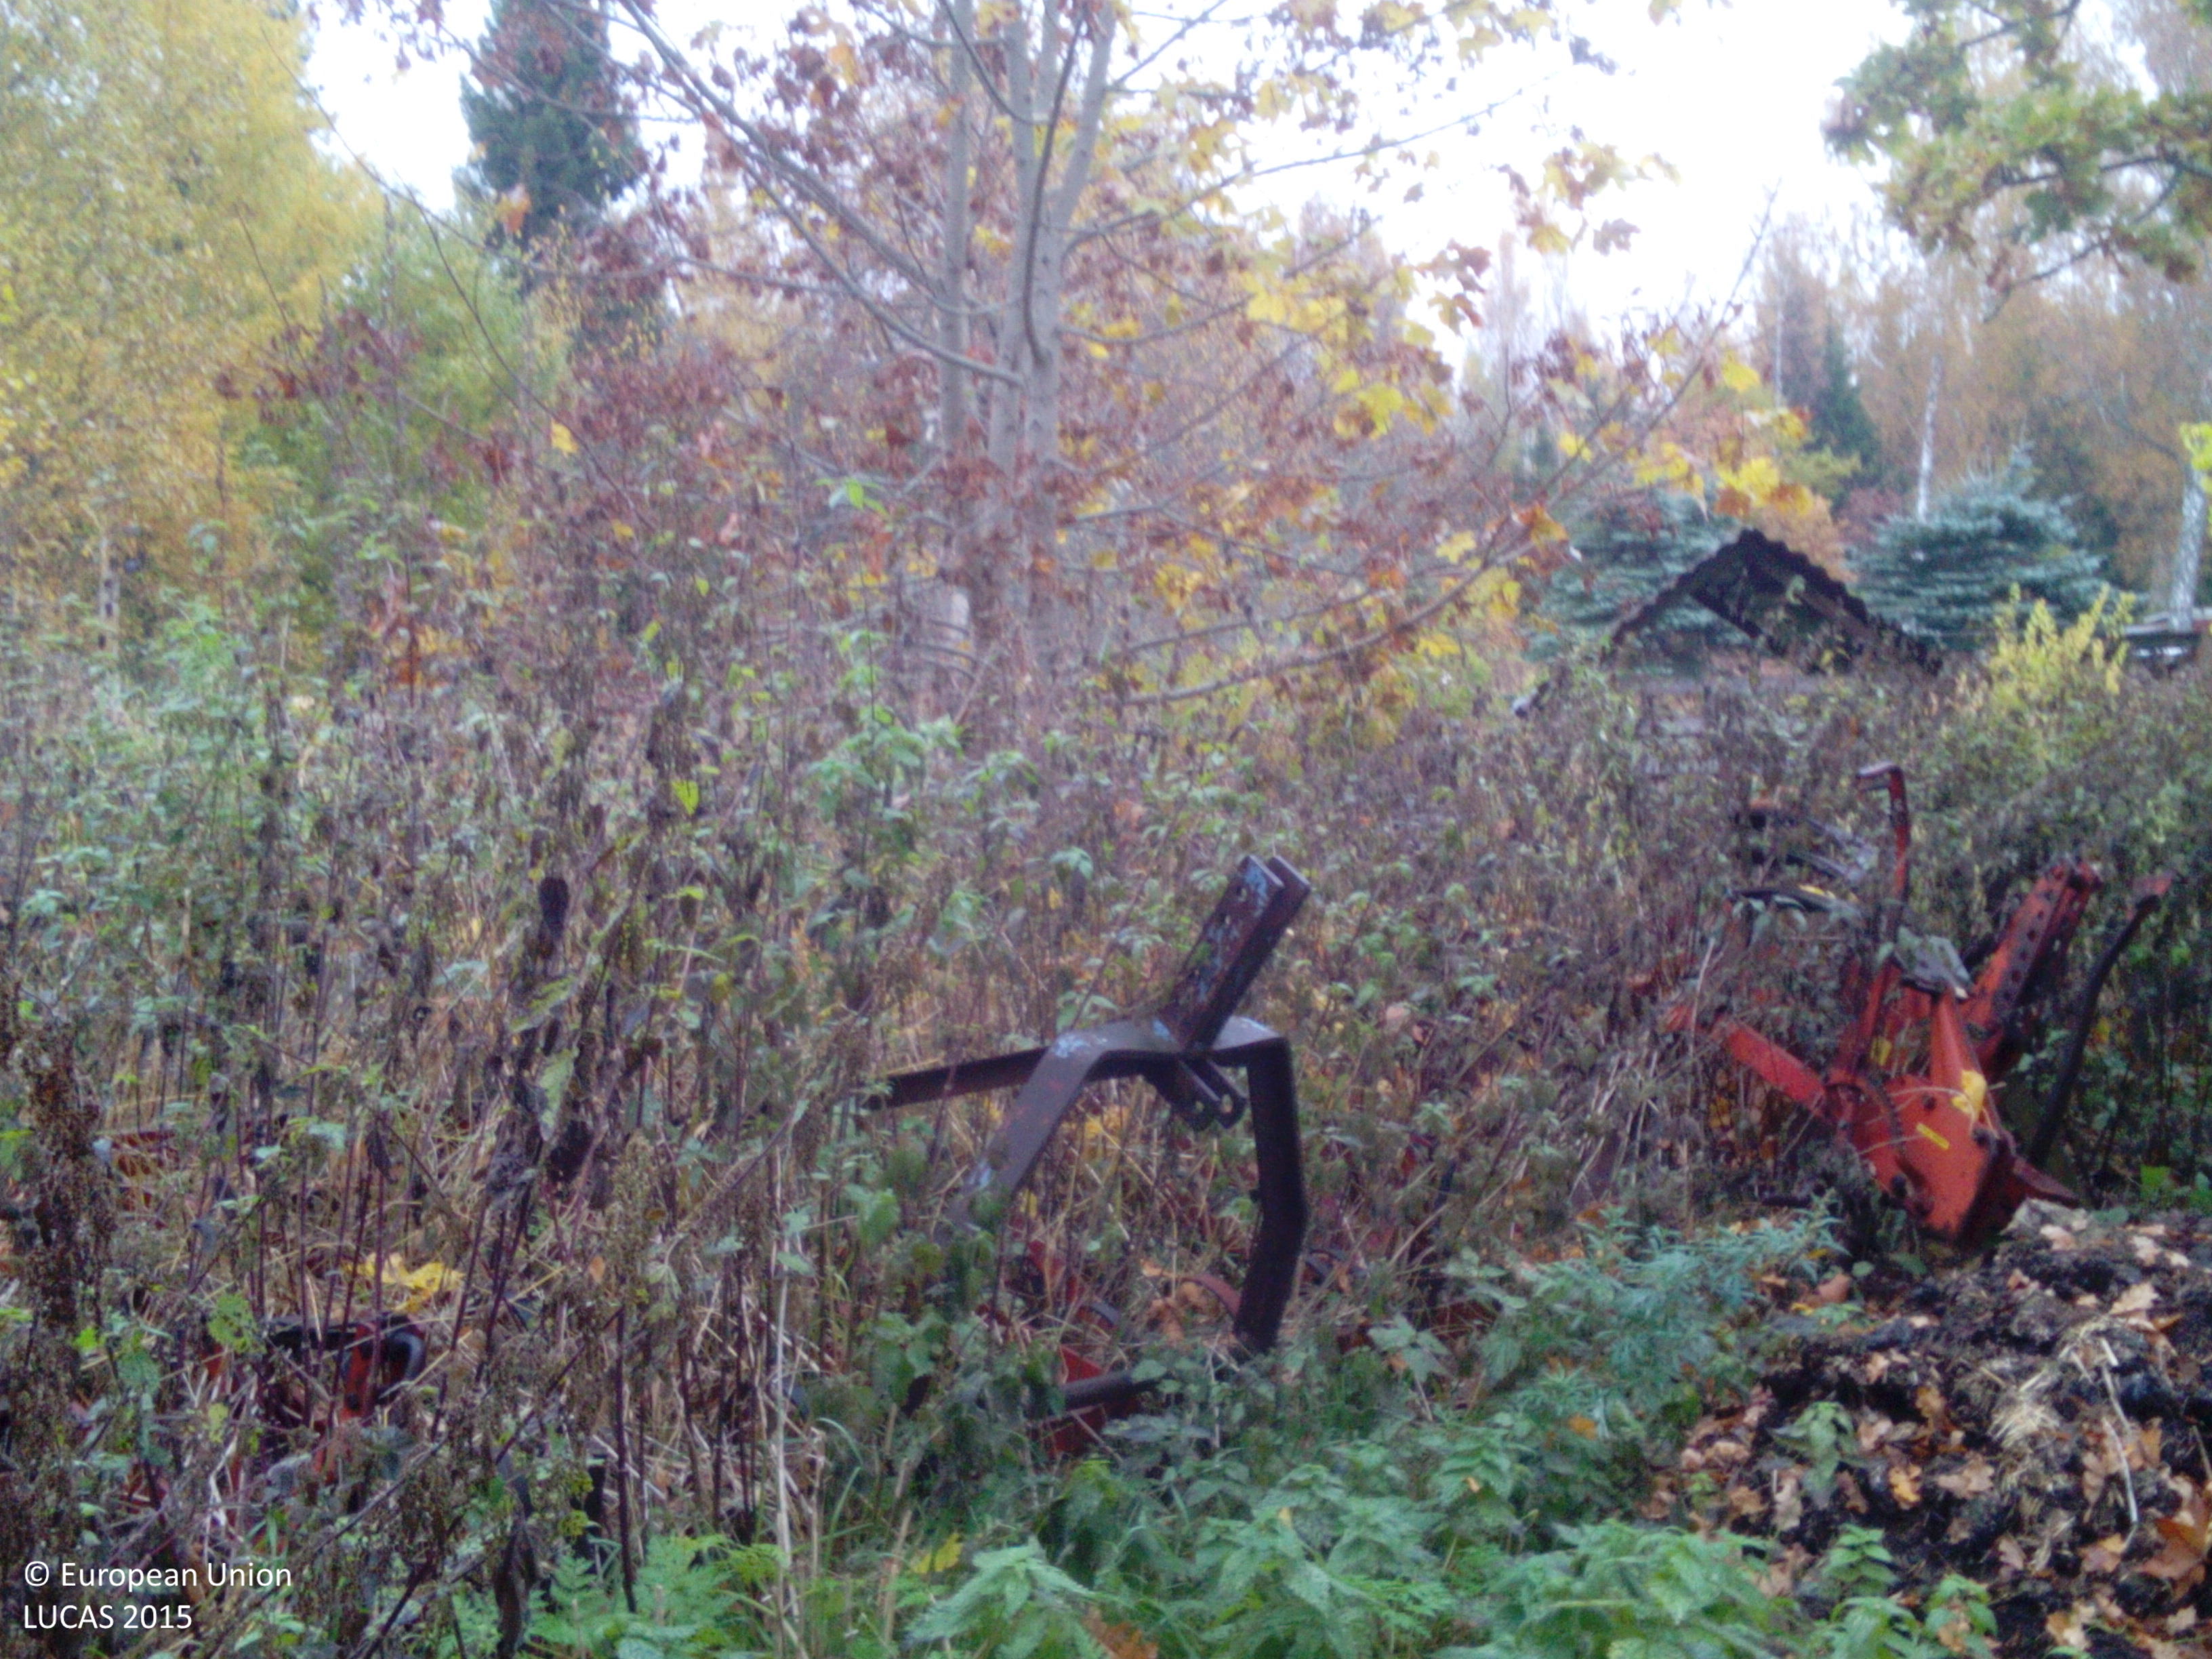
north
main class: Grassland
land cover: Grassland without tree/shrub cover
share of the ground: 50 - 75 %
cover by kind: herbaceous plants 70 %, consolidated bare surface 10 %
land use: Residential
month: October
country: SE
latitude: 59.0457
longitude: 16.3211
